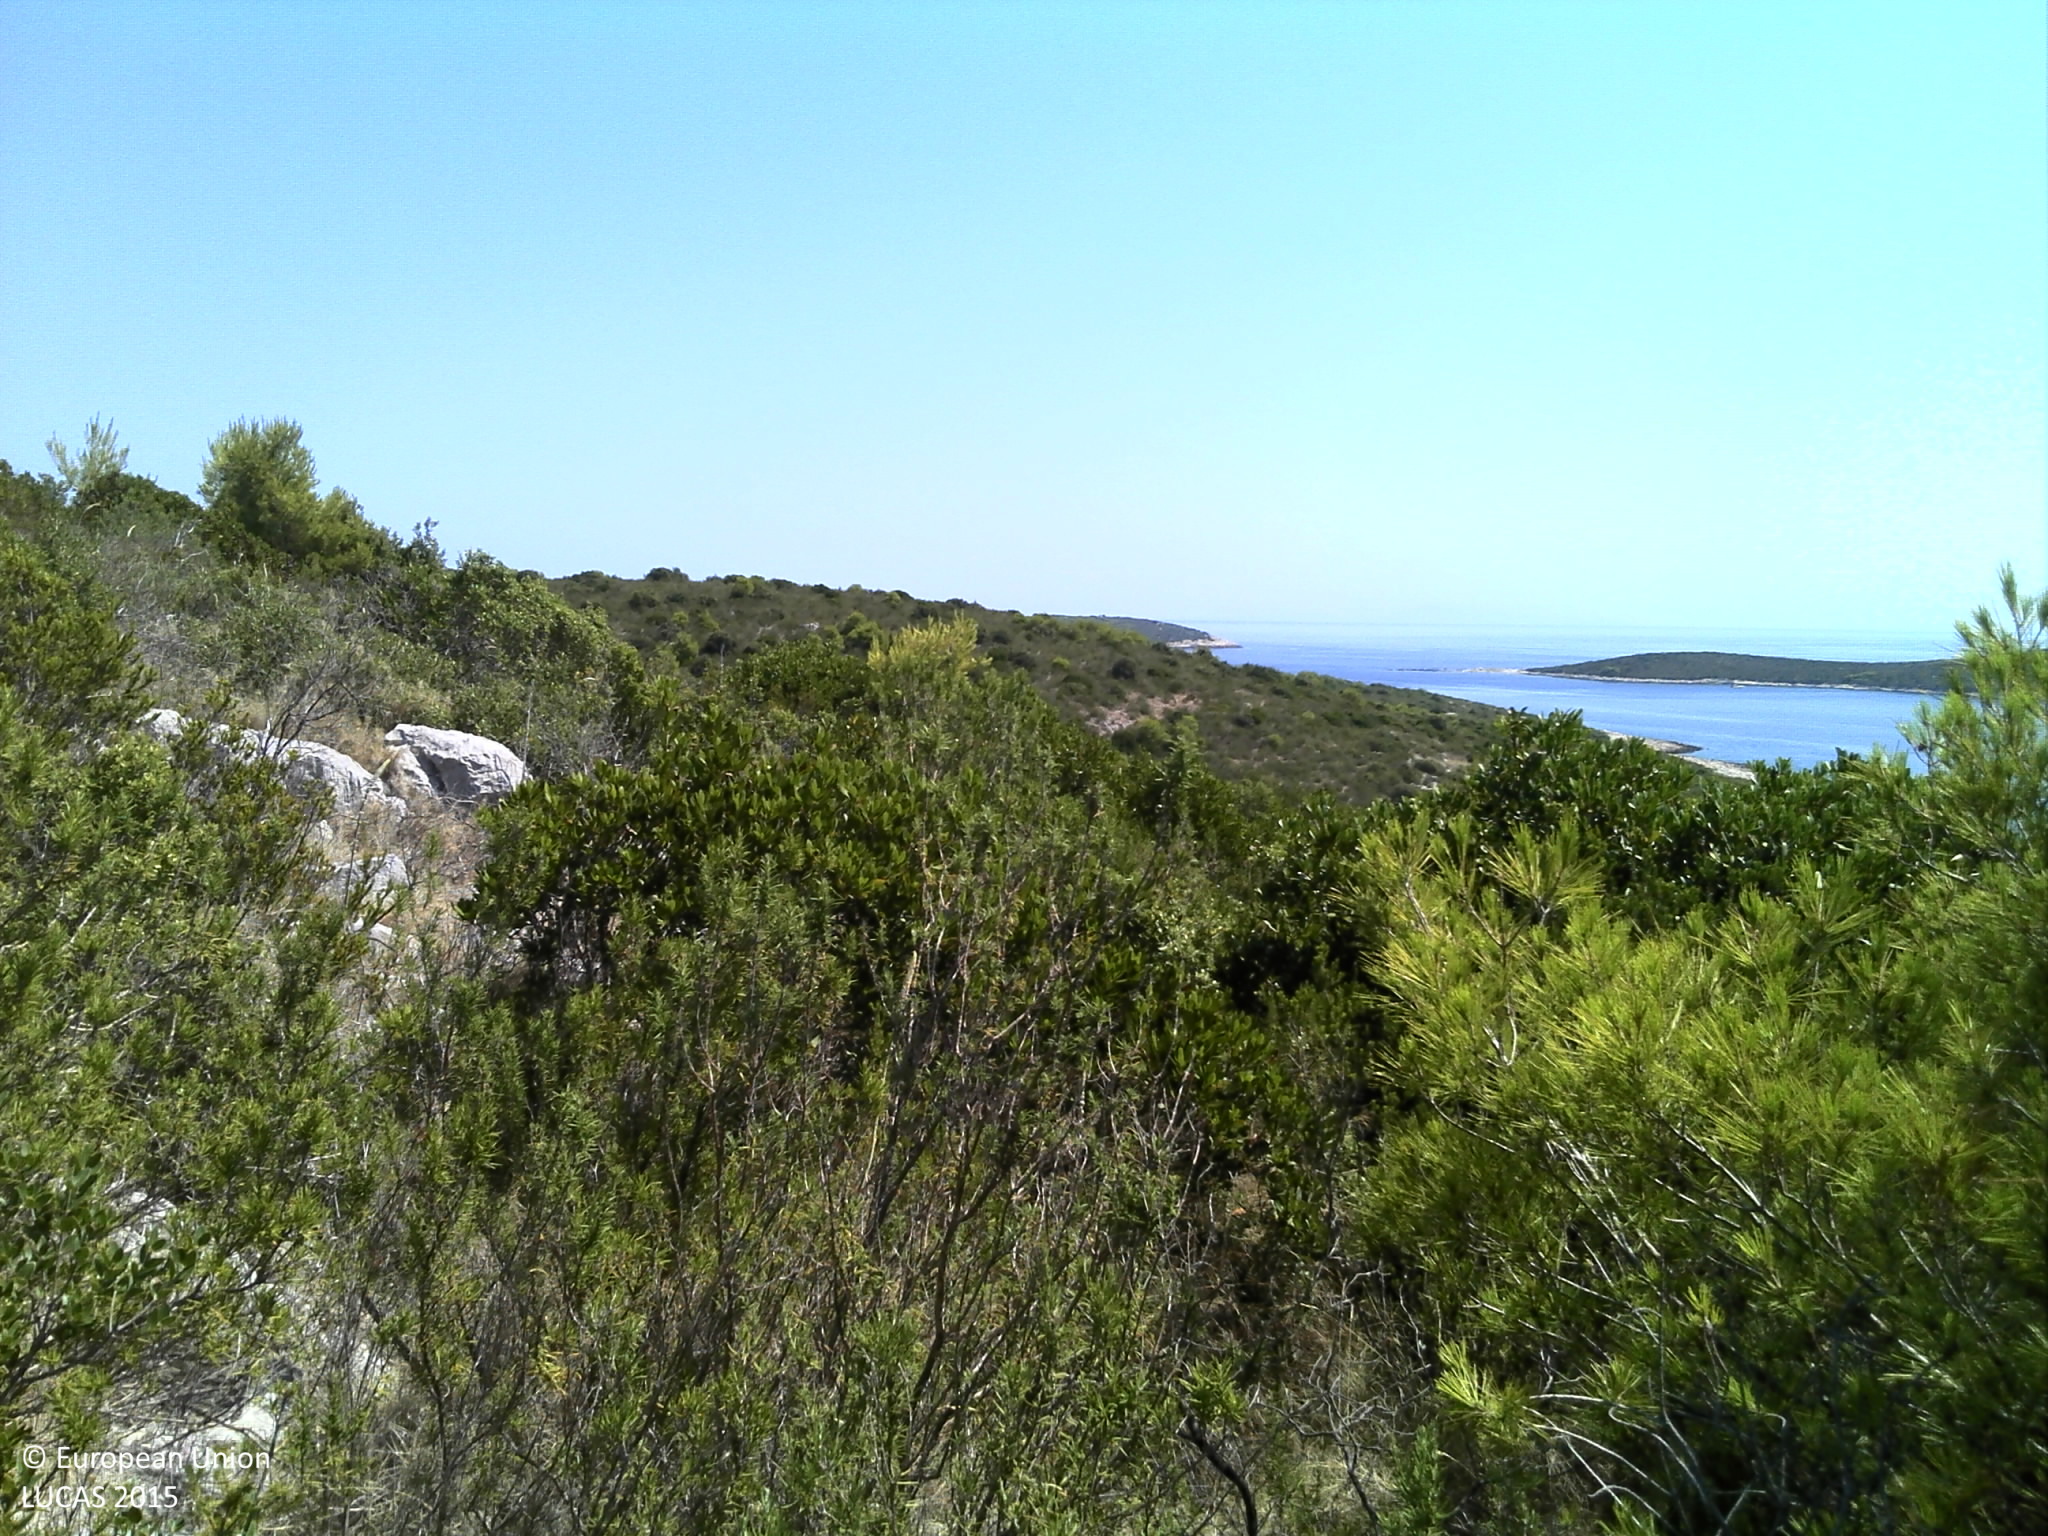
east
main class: Shrubland
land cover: Shrubland with sparse tree cover
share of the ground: > 75 %
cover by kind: shrubs 75 %, unconsolidated bare surface 10 %, coniferous forest trees 5 %, herbaceous plants 5 %, consolidated bare surface 5 %
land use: Semi-natural and natural areas not in use
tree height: > 5 m
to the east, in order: Shrubland with sparse tree cover; Tracks; Shrubland with sparse tree cover; Artificial constructions in urban areas; Inland salty water bodies; Rocks and stones; Shrubland with sparse tree cover
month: August
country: HR
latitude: 43.0246
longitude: 16.2102
